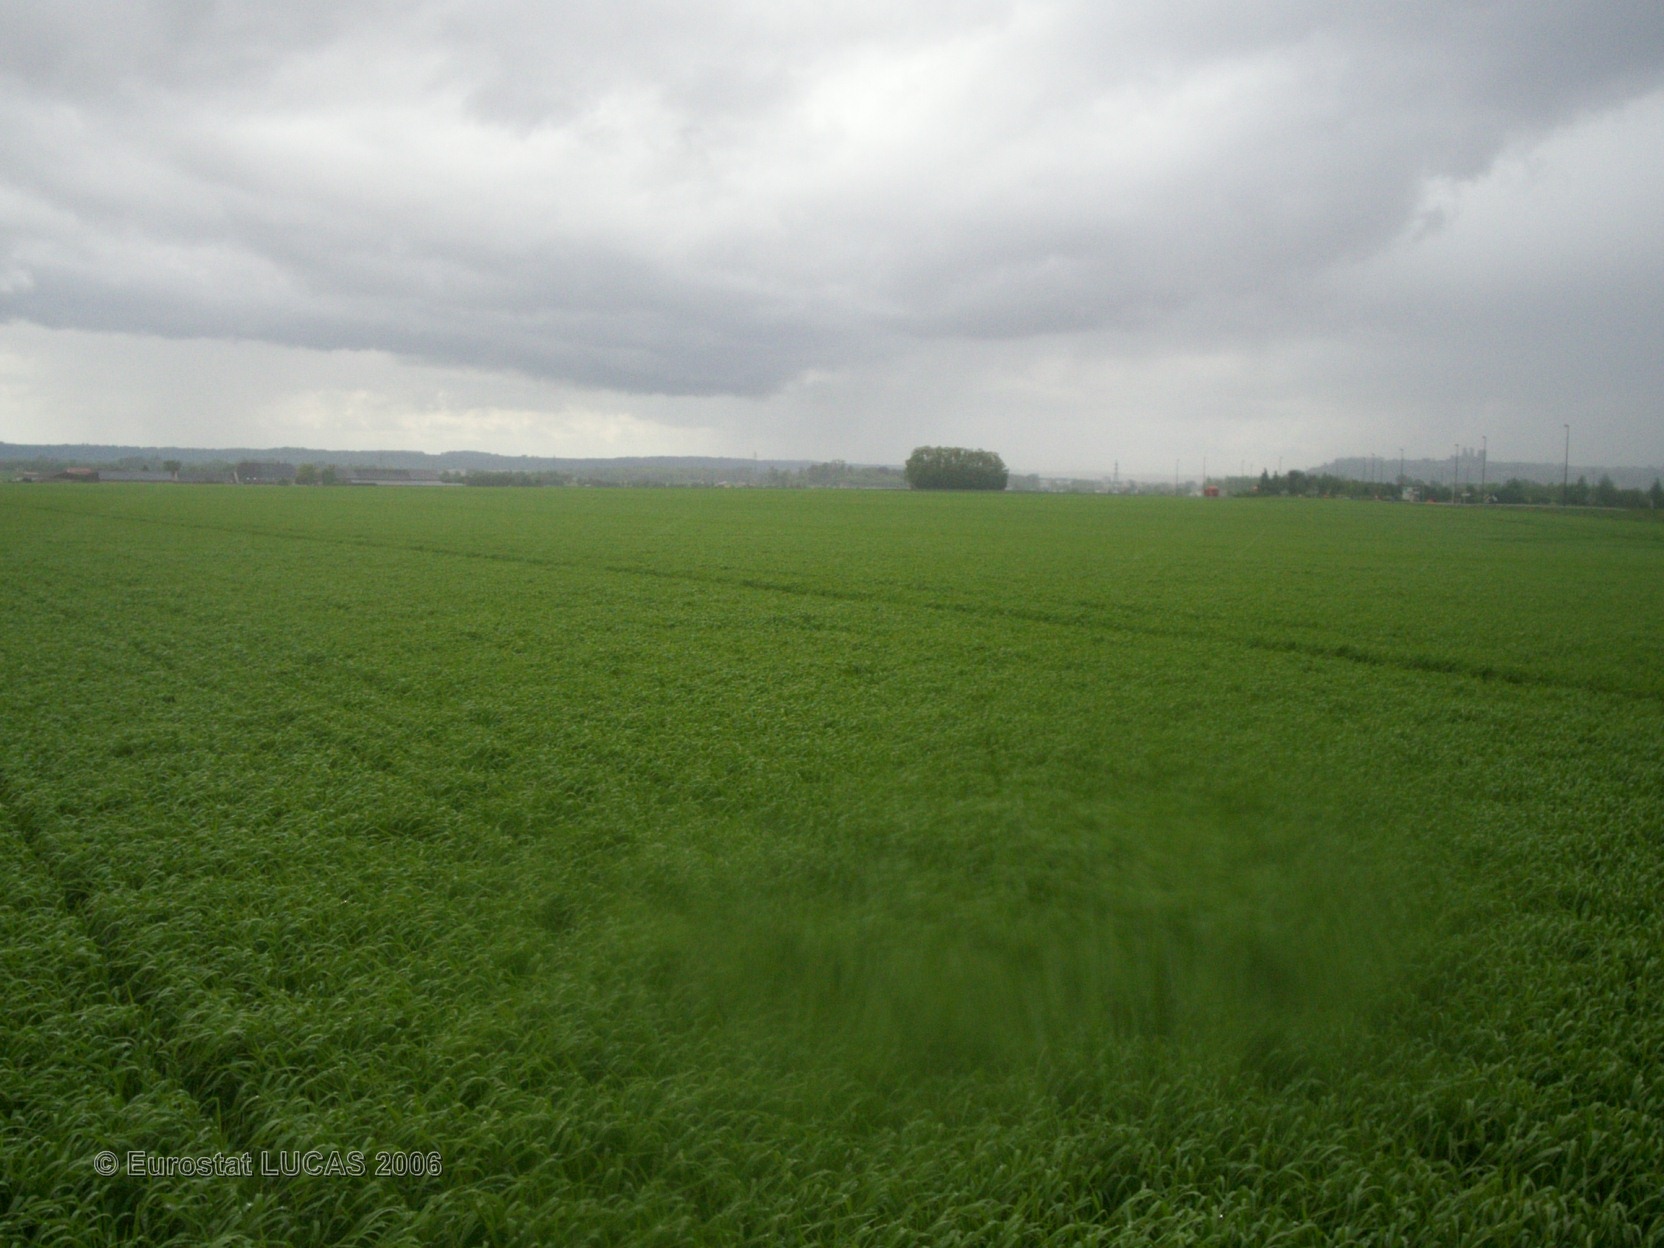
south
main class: Cropland
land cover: Barley
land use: Agriculture (excluding fallow land and kitchen gardens)
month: May
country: FR
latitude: 49.6114
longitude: 3.6687
